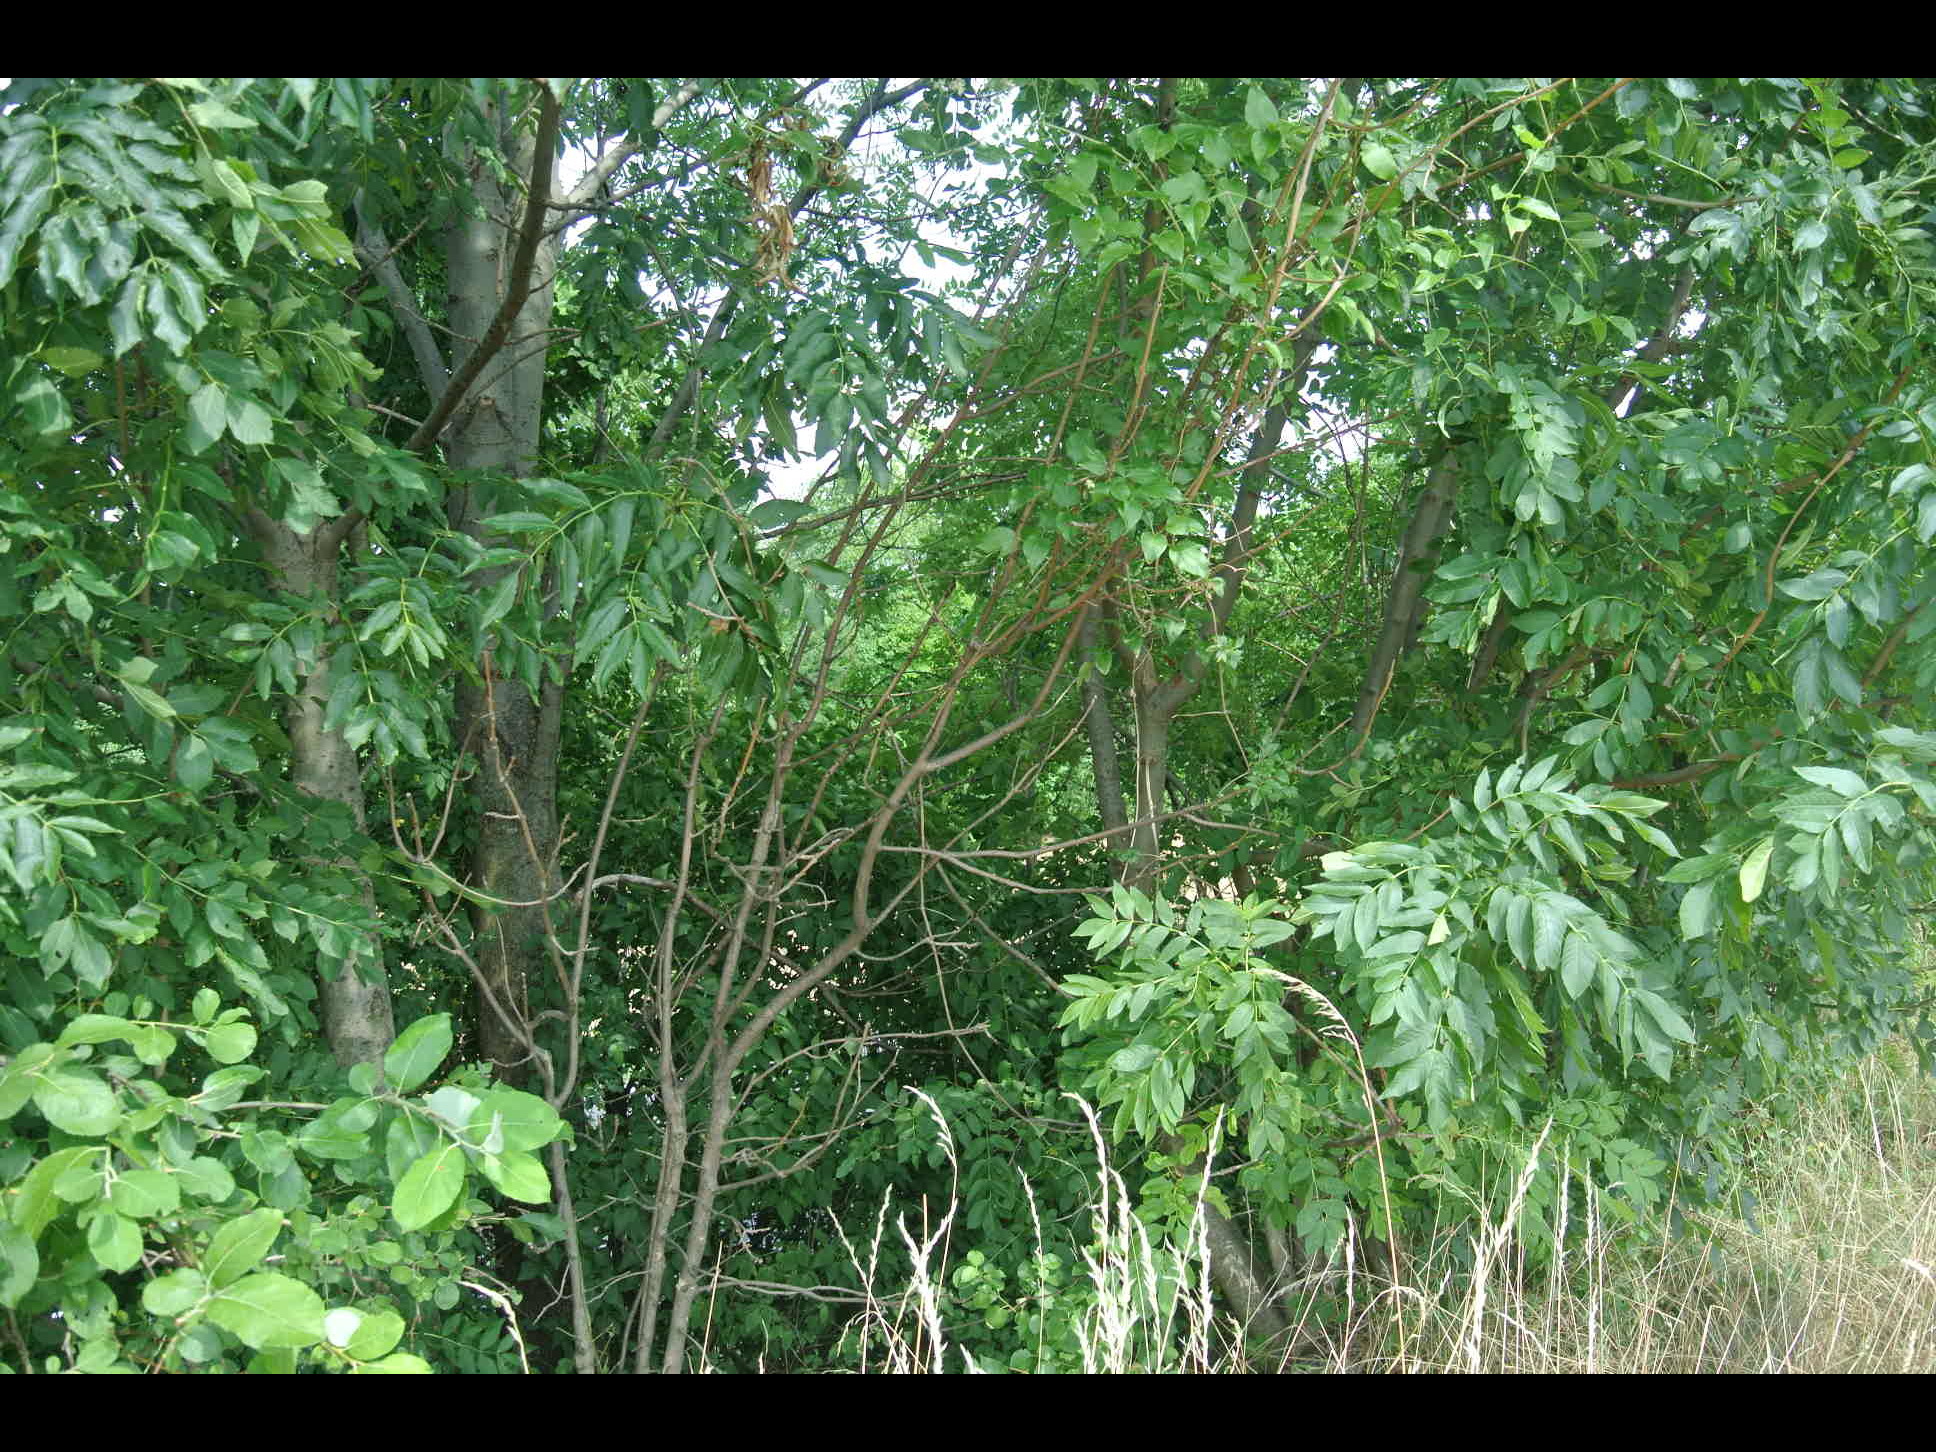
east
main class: Cropland
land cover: Common wheat
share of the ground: > 75 %
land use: Agriculture (excluding fallow land and kitchen gardens)
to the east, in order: Common wheat; Broadleaved woodland; Grass margins; Paved roads, cycling and walking lanes; Grass margins; Broadleaved woodland; Sunflower; Common wheat
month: July
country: AT
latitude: 47.7135
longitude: 16.0677
